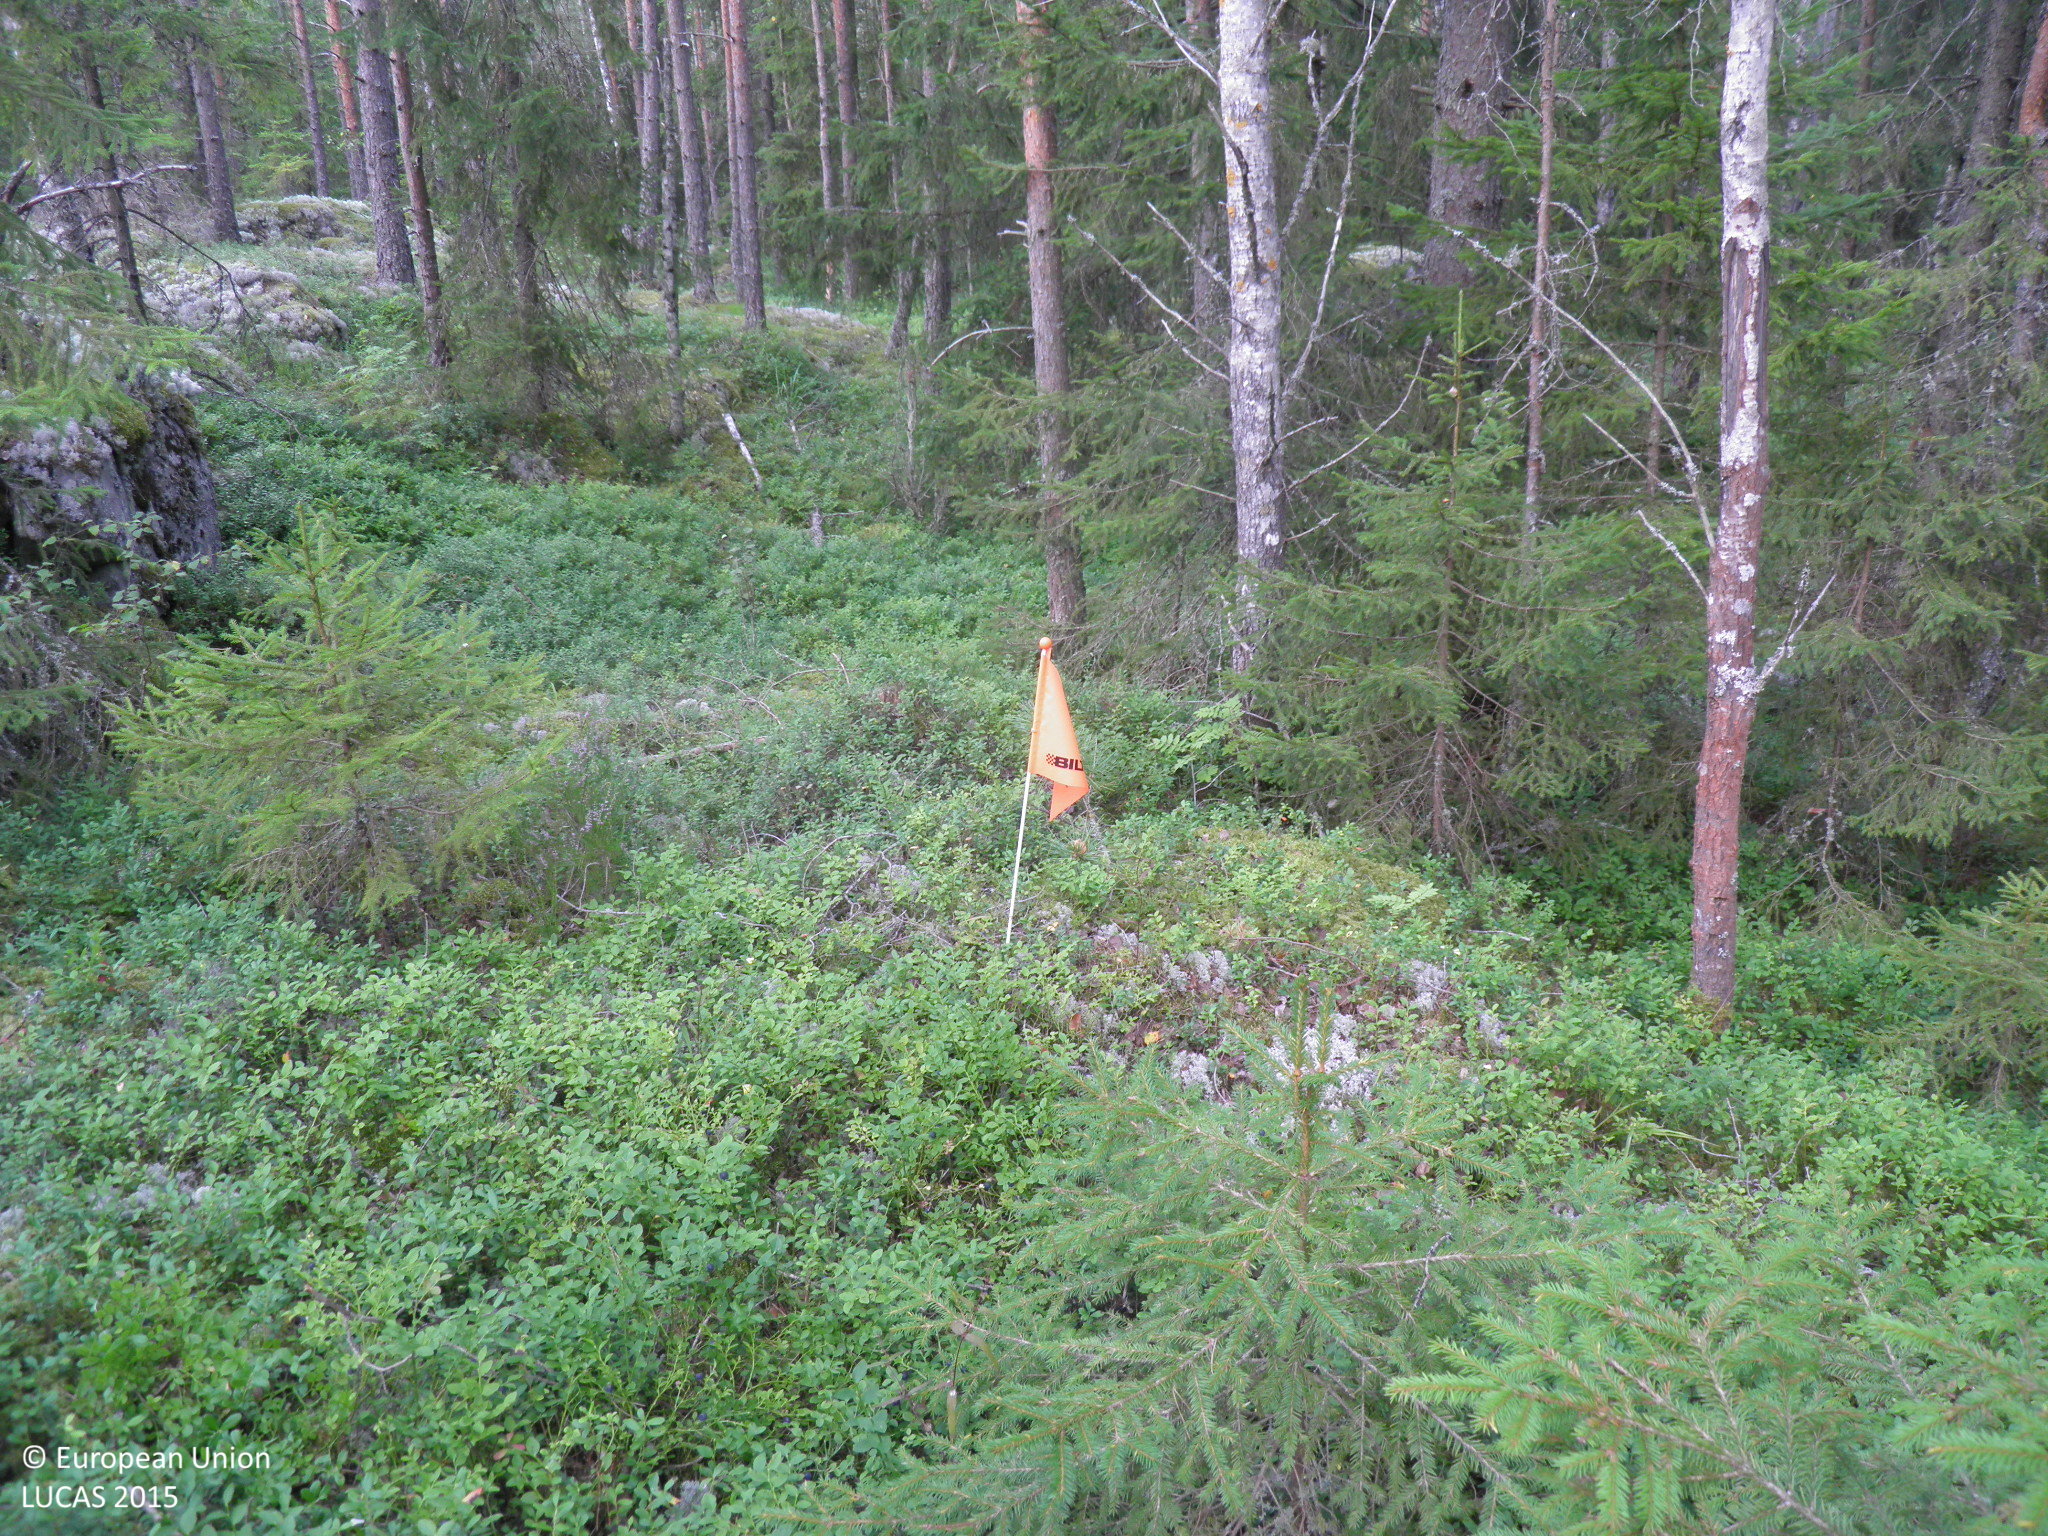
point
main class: Woodland
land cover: Pine dominated mixed woodland
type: hemiboreal forest and nemoral coniferous forest and mixed broadleaved-coniferous forest
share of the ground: 50 - 75 %
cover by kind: coniferous forest trees 30 %, lichens and mosses 30 %, broadleaved forest trees 20 %, shrubs 20 %
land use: Forestry
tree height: > 5 m
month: August
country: FI
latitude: 61.1680
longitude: 22.5773
